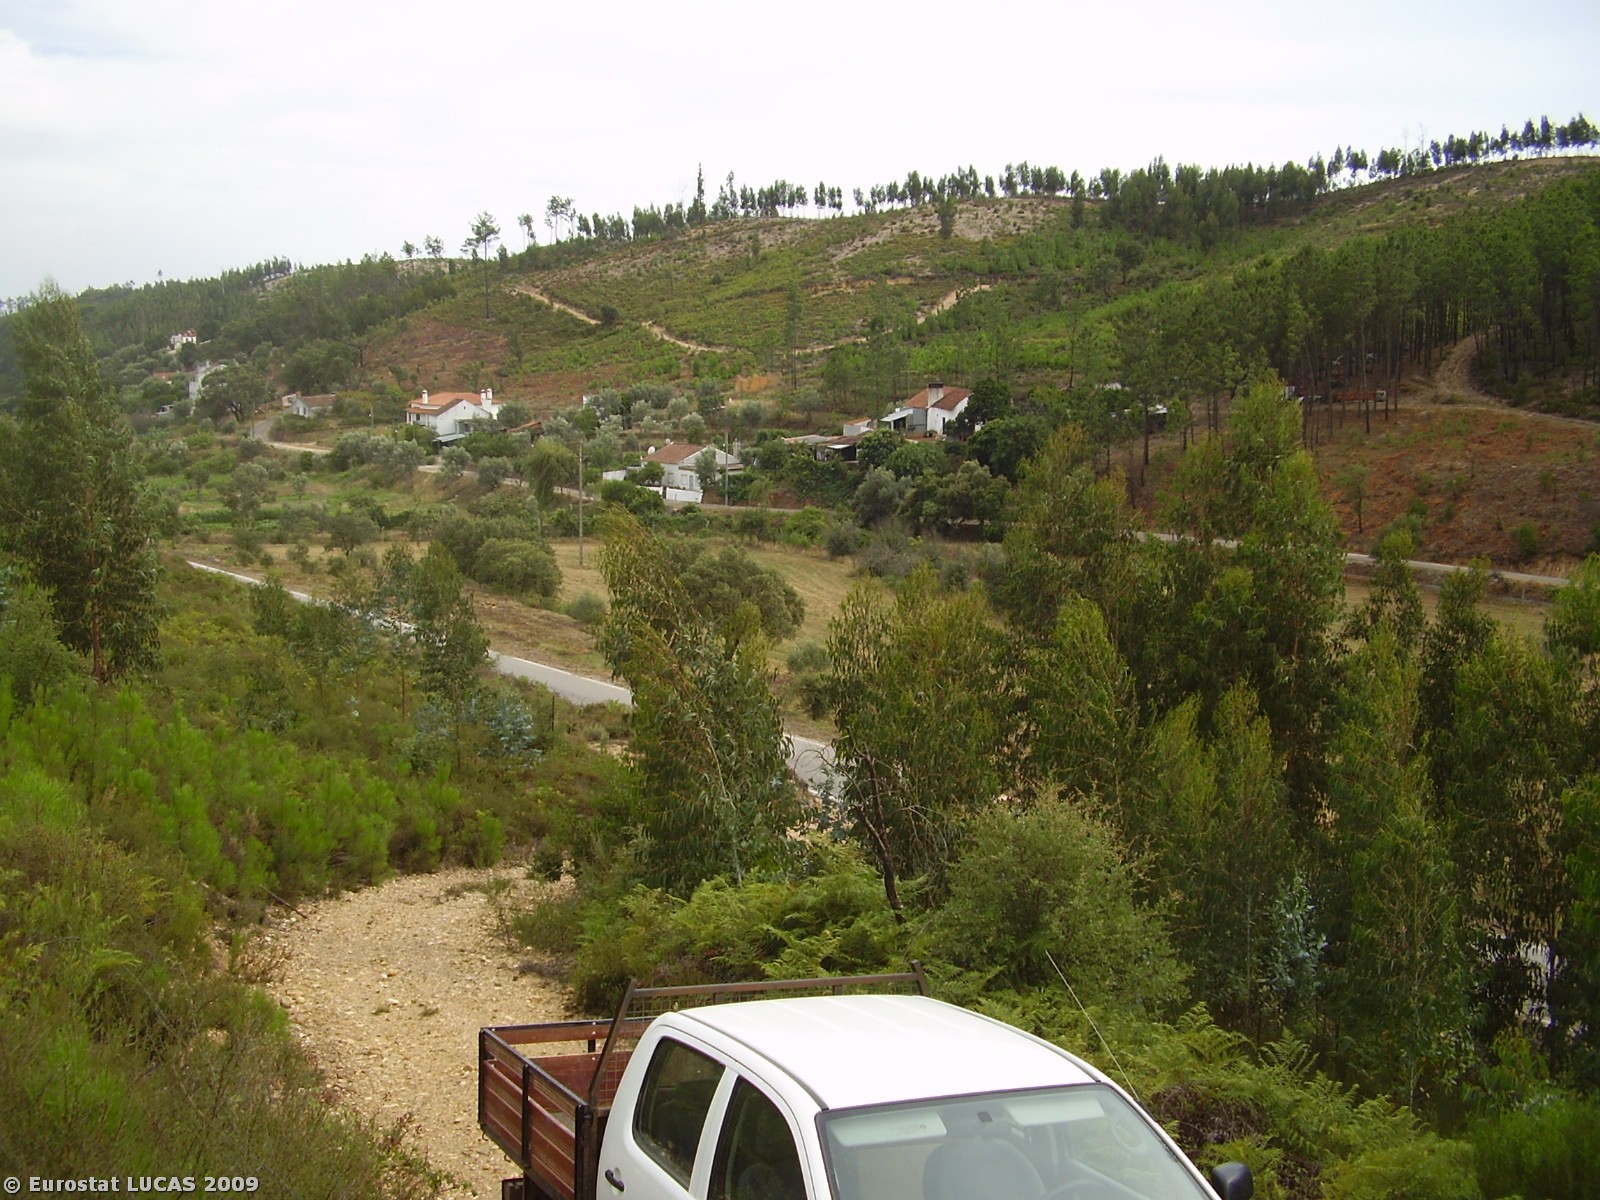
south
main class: Woodland
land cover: Coniferous woodland
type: coniferous forest of the mediterranean region
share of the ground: 50 - 75 %
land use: Forestry
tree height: > 5 m
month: July
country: PT
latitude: 39.5197
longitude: -8.2473
